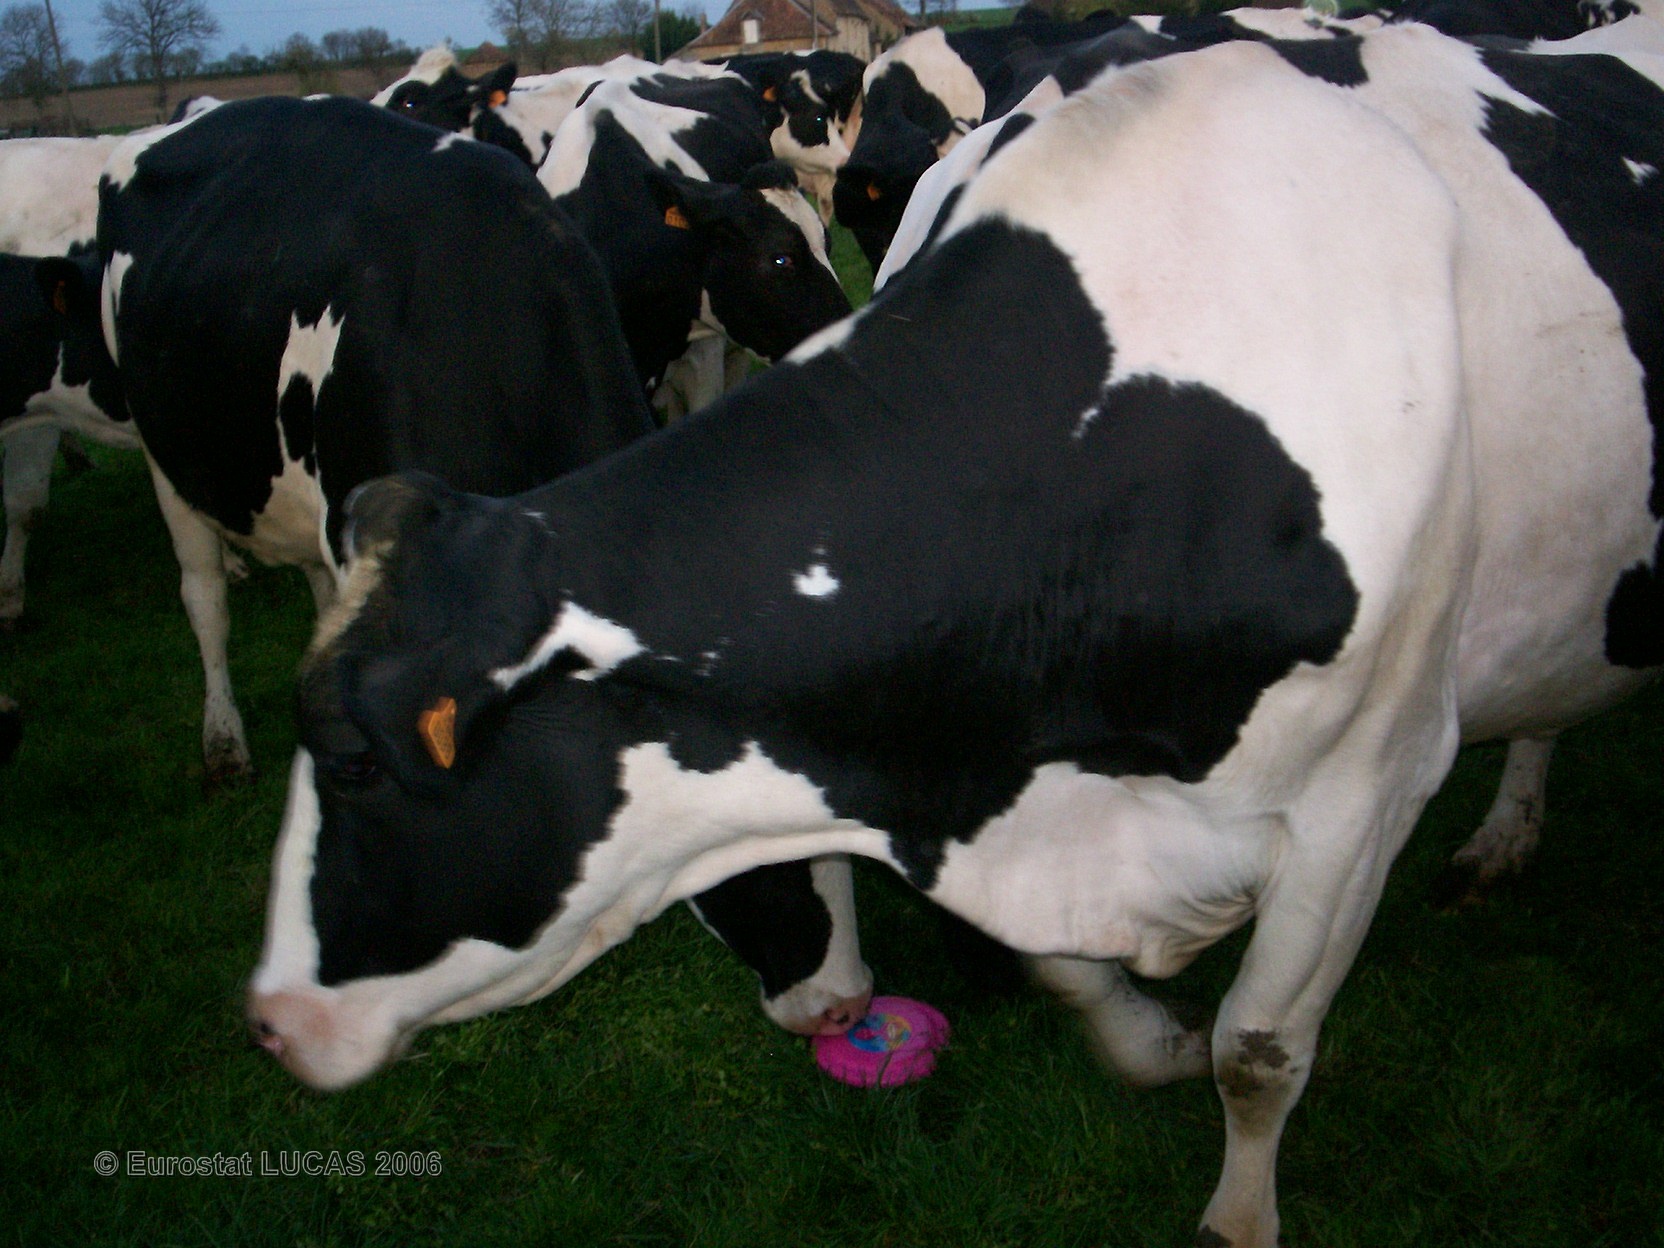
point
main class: Grassland
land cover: Grassland without tree/shrub cover
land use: Agriculture (excluding fallow land and kitchen gardens)
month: April
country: FR
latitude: 48.3041
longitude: 0.1169
